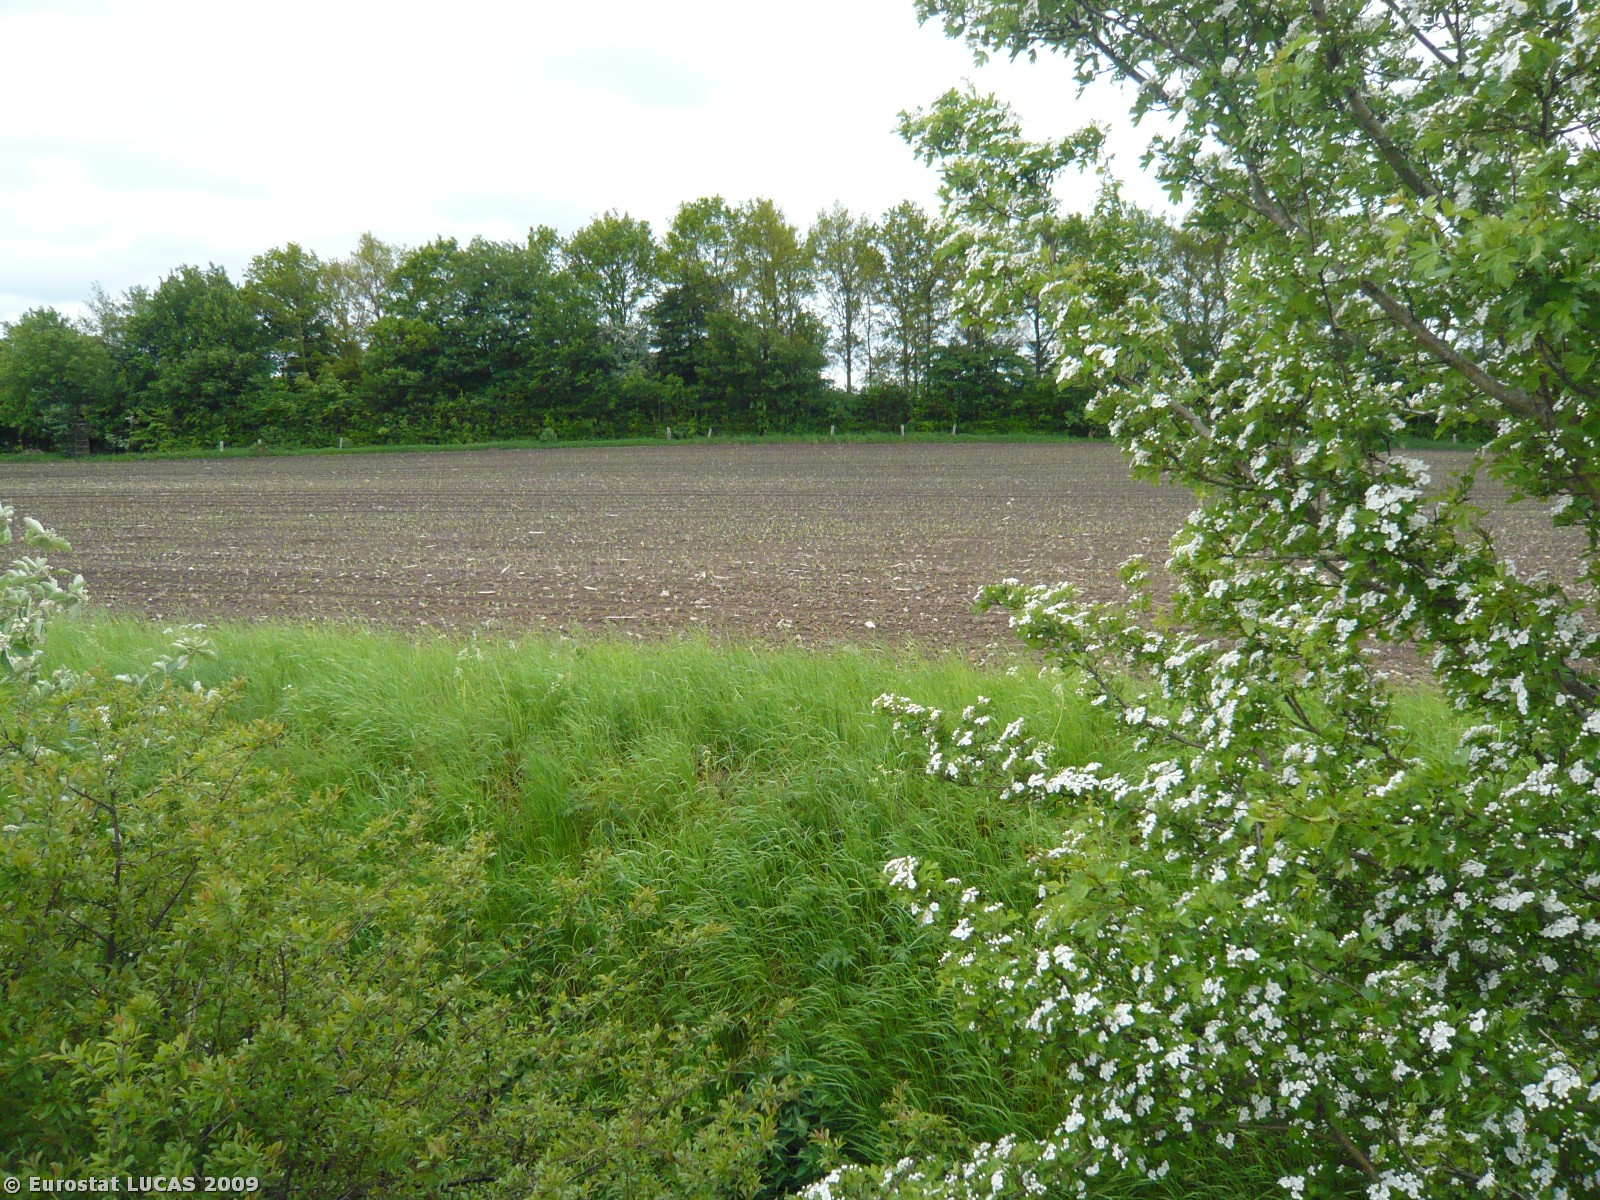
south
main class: Grassland
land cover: Grassland without tree/shrub cover
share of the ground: > 75 %
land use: Agriculture (excluding fallow land and kitchen gardens)
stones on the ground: < 10 %
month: May
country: DK
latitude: 55.4391
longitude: 11.7214
